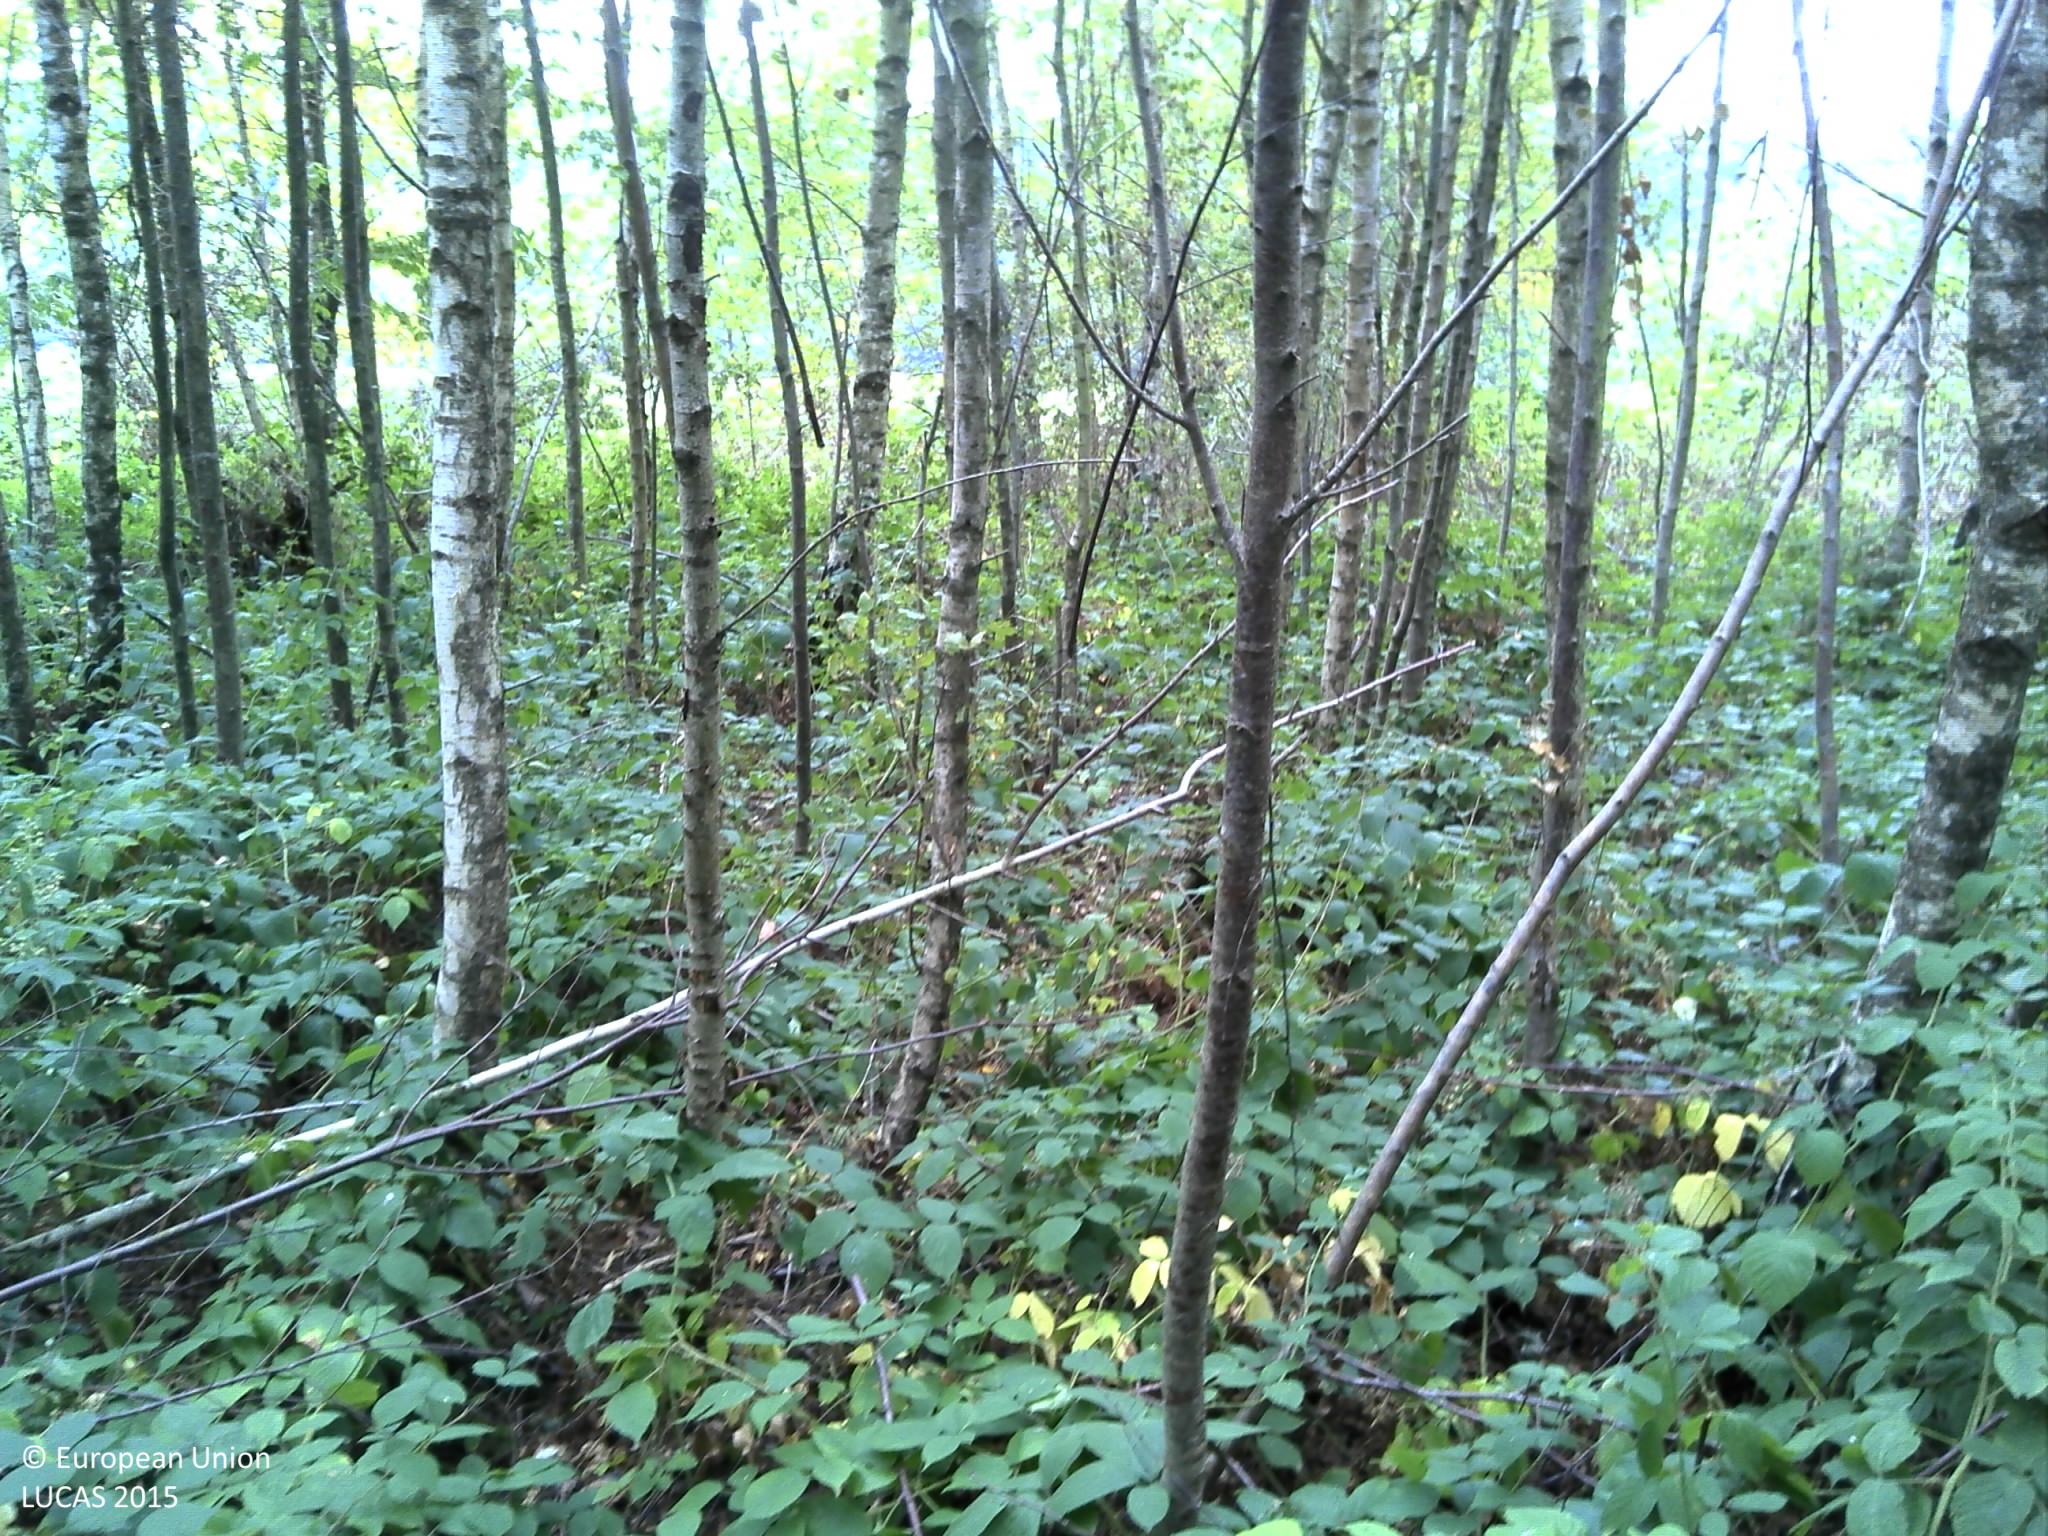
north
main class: Woodland
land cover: Broadleaved woodland
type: acidophilous oak and oak-birch forest
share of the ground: > 75 %
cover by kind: broadleaved forest trees 90 %, herbaceous plants 10 %
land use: Forestry
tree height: > 5 m
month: August
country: FR
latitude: 48.3409
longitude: 6.8573
